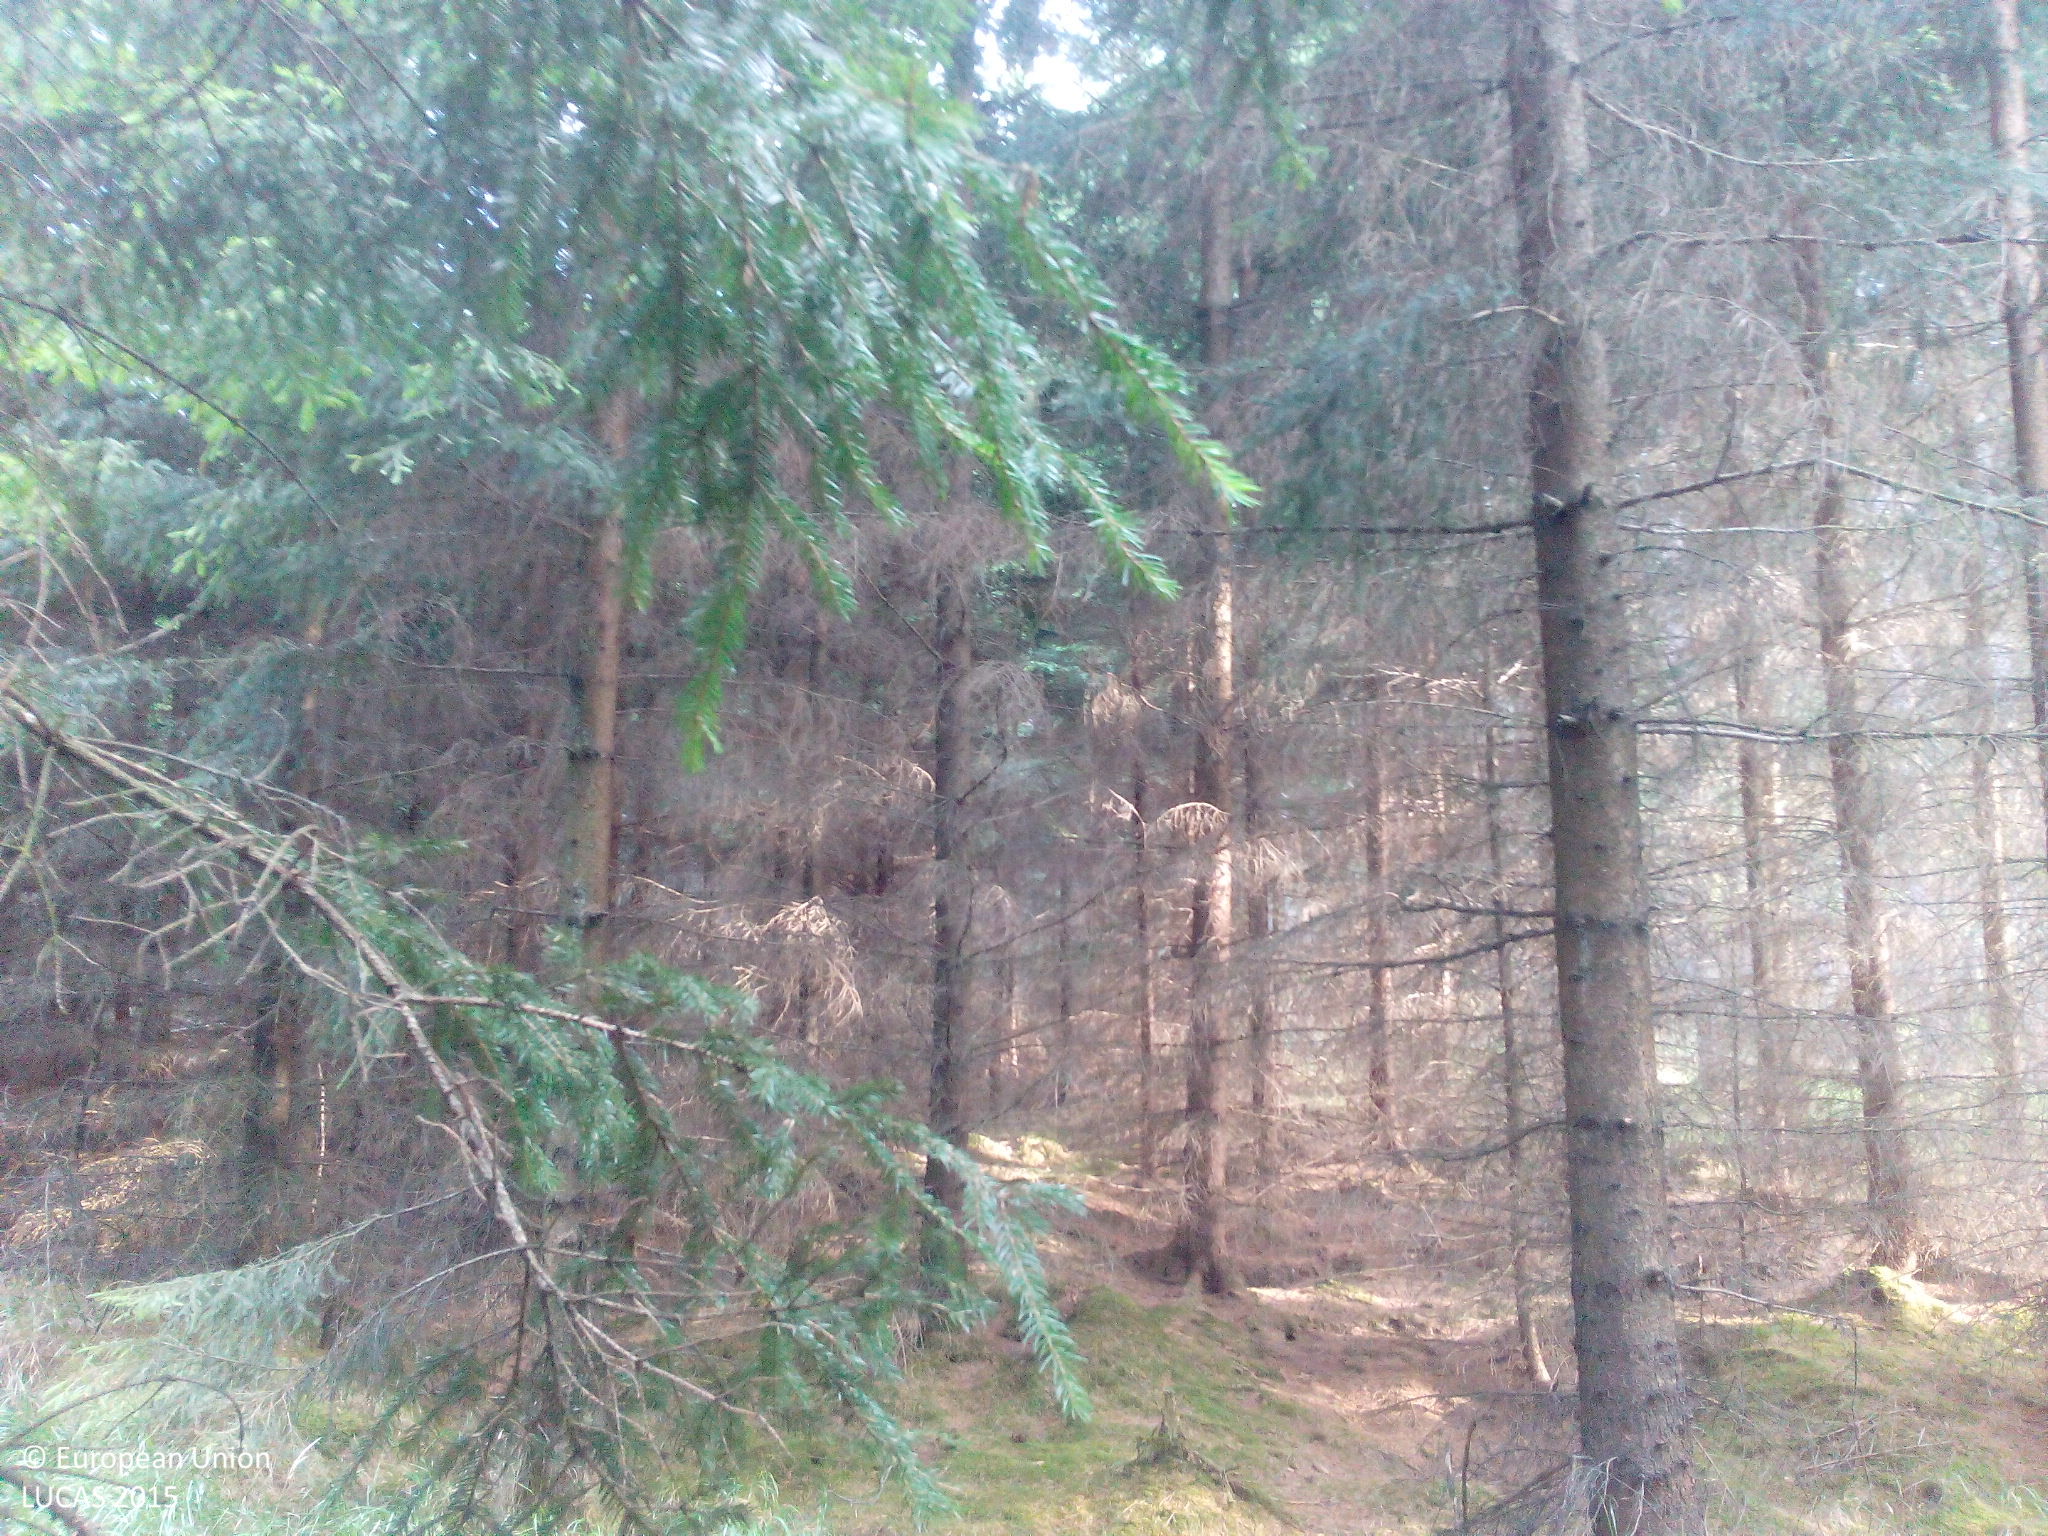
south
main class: Woodland
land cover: Spruce dominated coniferous woodland
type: hemiboreal forest and nemoral coniferous forest and mixed broadleaved-coniferous forest
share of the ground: > 75 %
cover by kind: coniferous forest trees 90 %, herbaceous plants 10 %
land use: Forestry
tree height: > 5 m
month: July
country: DE
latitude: 50.9400
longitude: 13.5156
